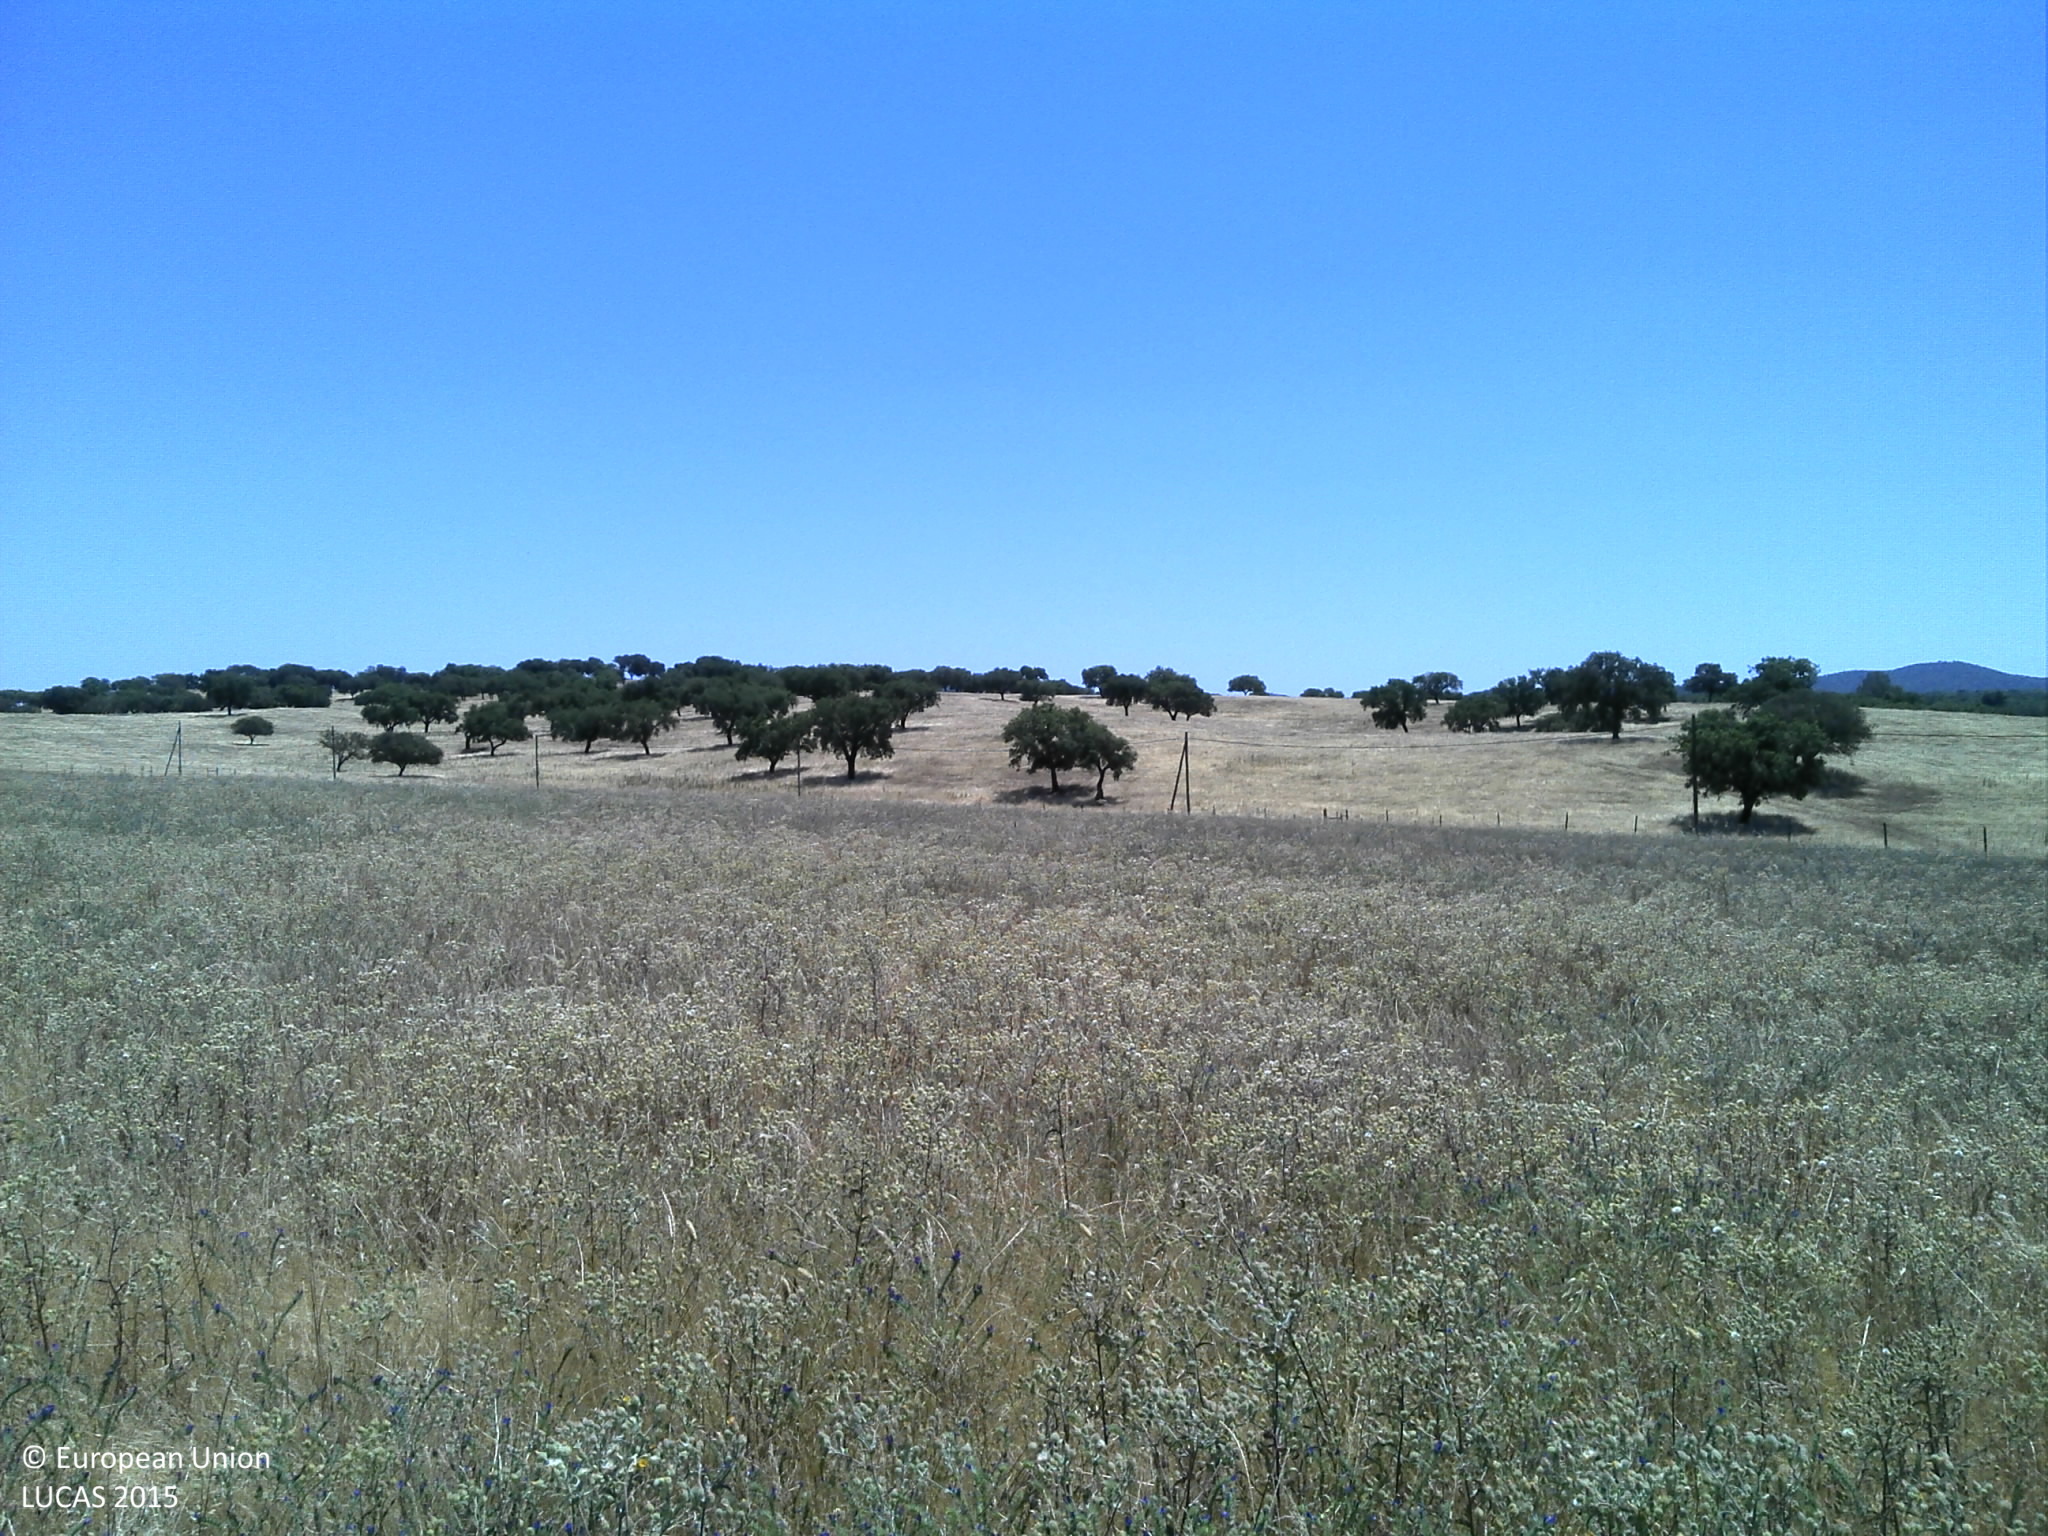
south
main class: Grassland
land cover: Spontaneously vegetated surfaces
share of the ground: > 75 %
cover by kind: herbaceous plants 90 %, unconsolidated bare surface 10 %
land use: Agriculture (excluding fallow land and kitchen gardens)
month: June
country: PT
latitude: 38.8336
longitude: -7.7700
